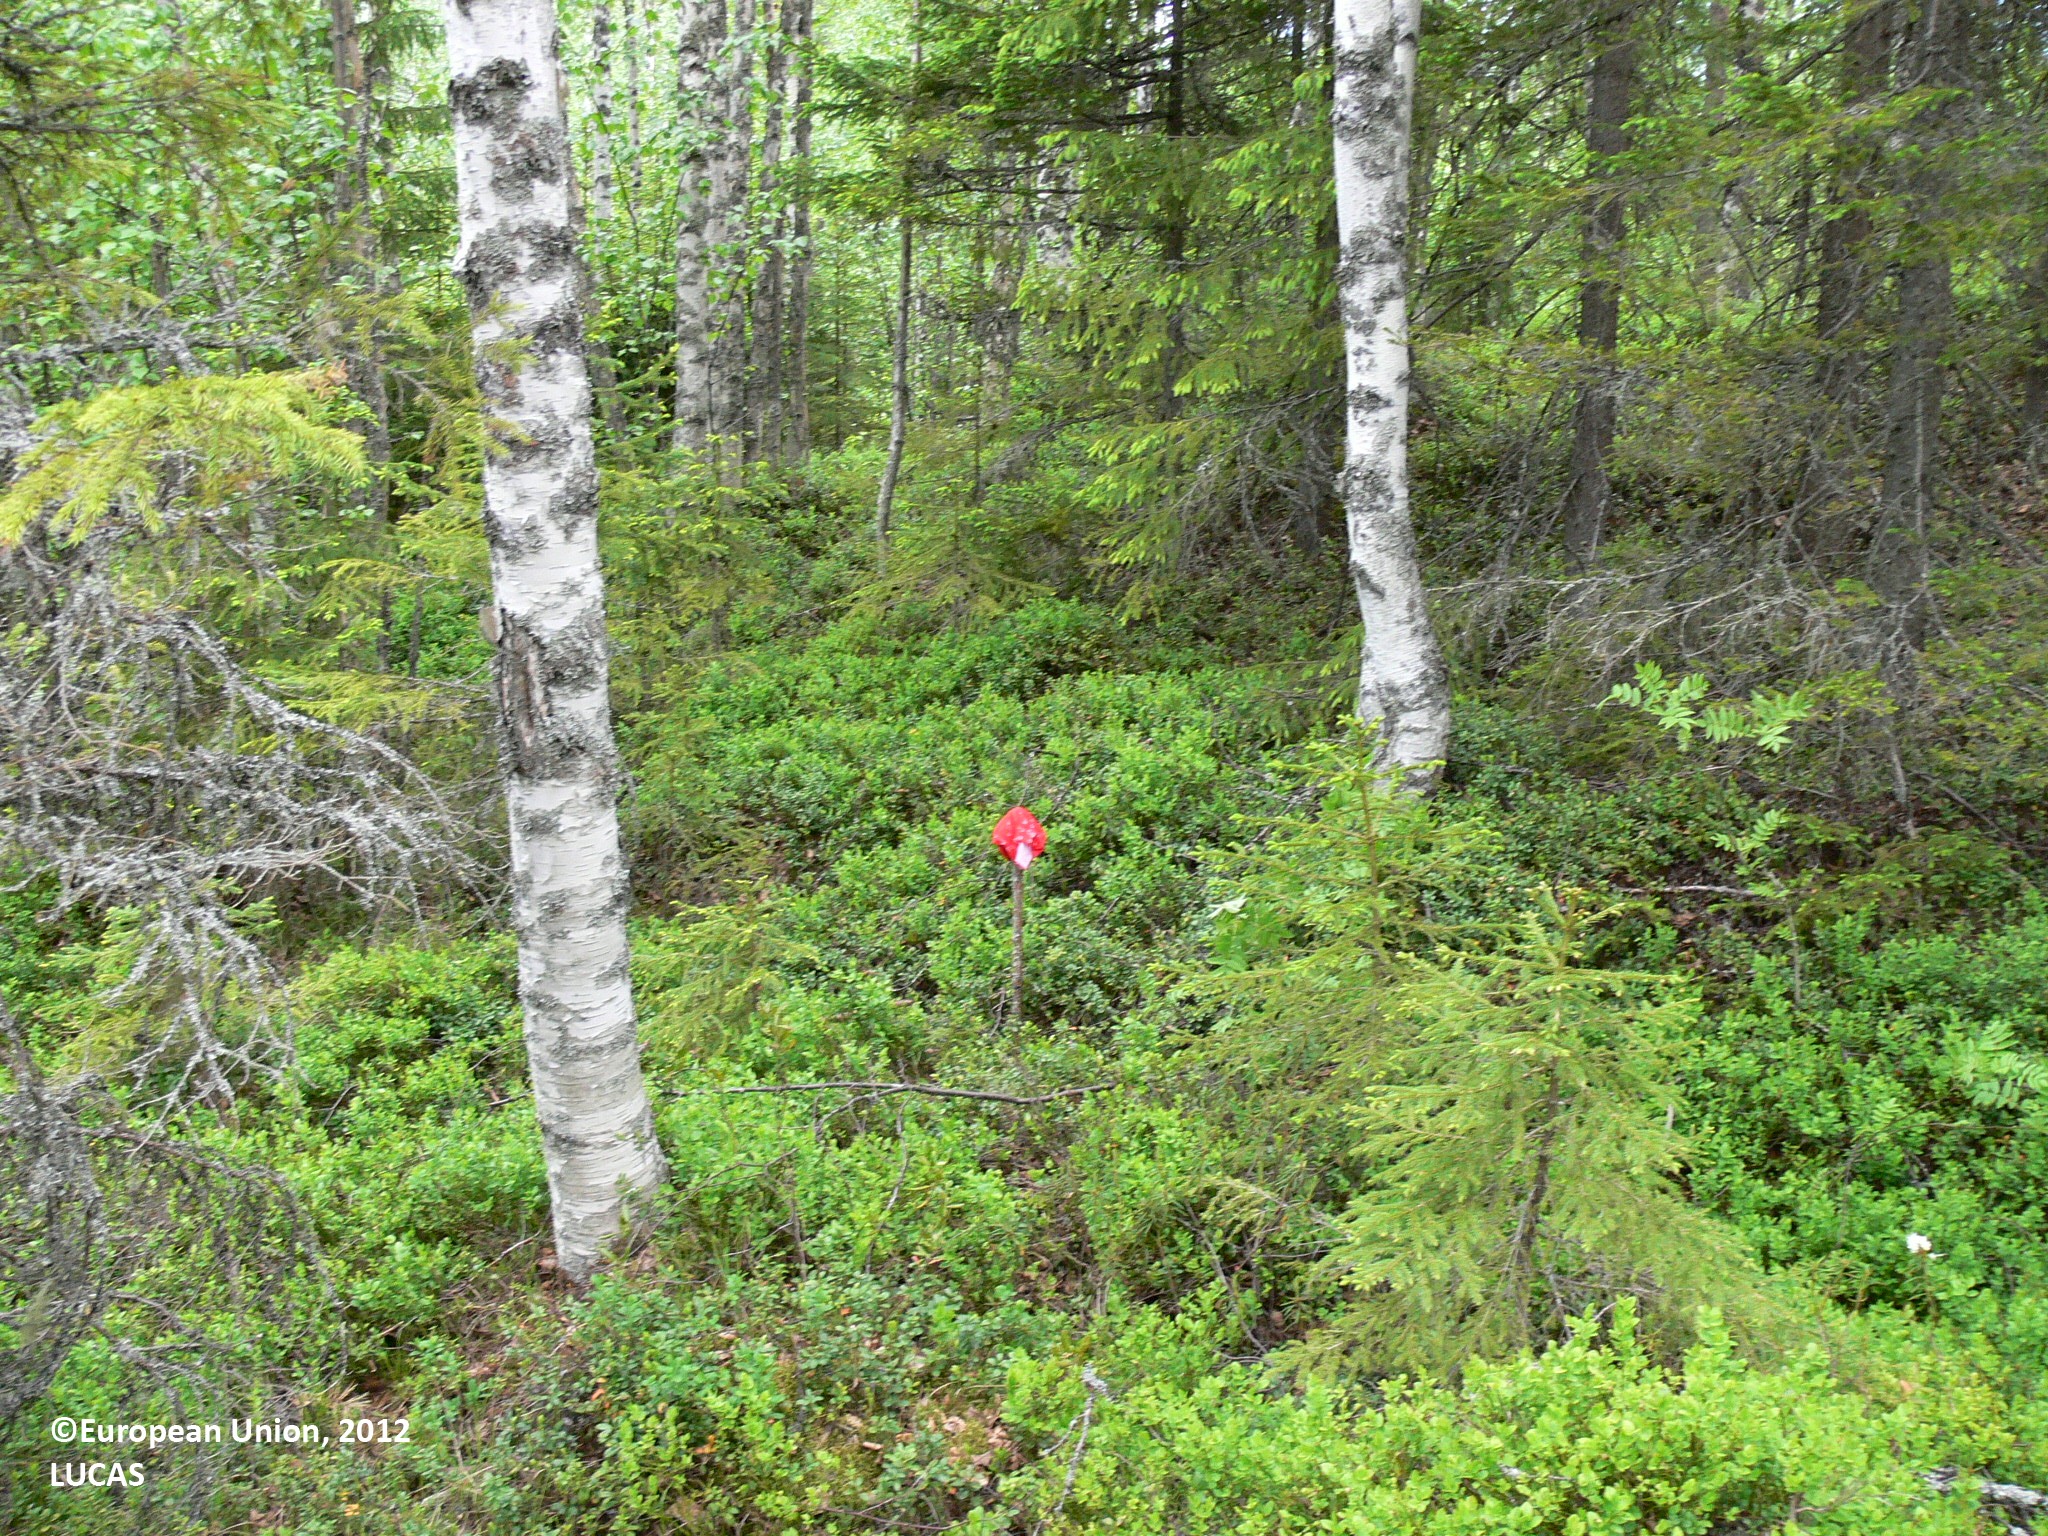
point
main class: Woodland
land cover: Other mixed woodland
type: boreal forest
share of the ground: > 75 %
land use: Forestry
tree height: > 5 m
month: June
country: FI
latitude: 62.6141
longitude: 30.4070
